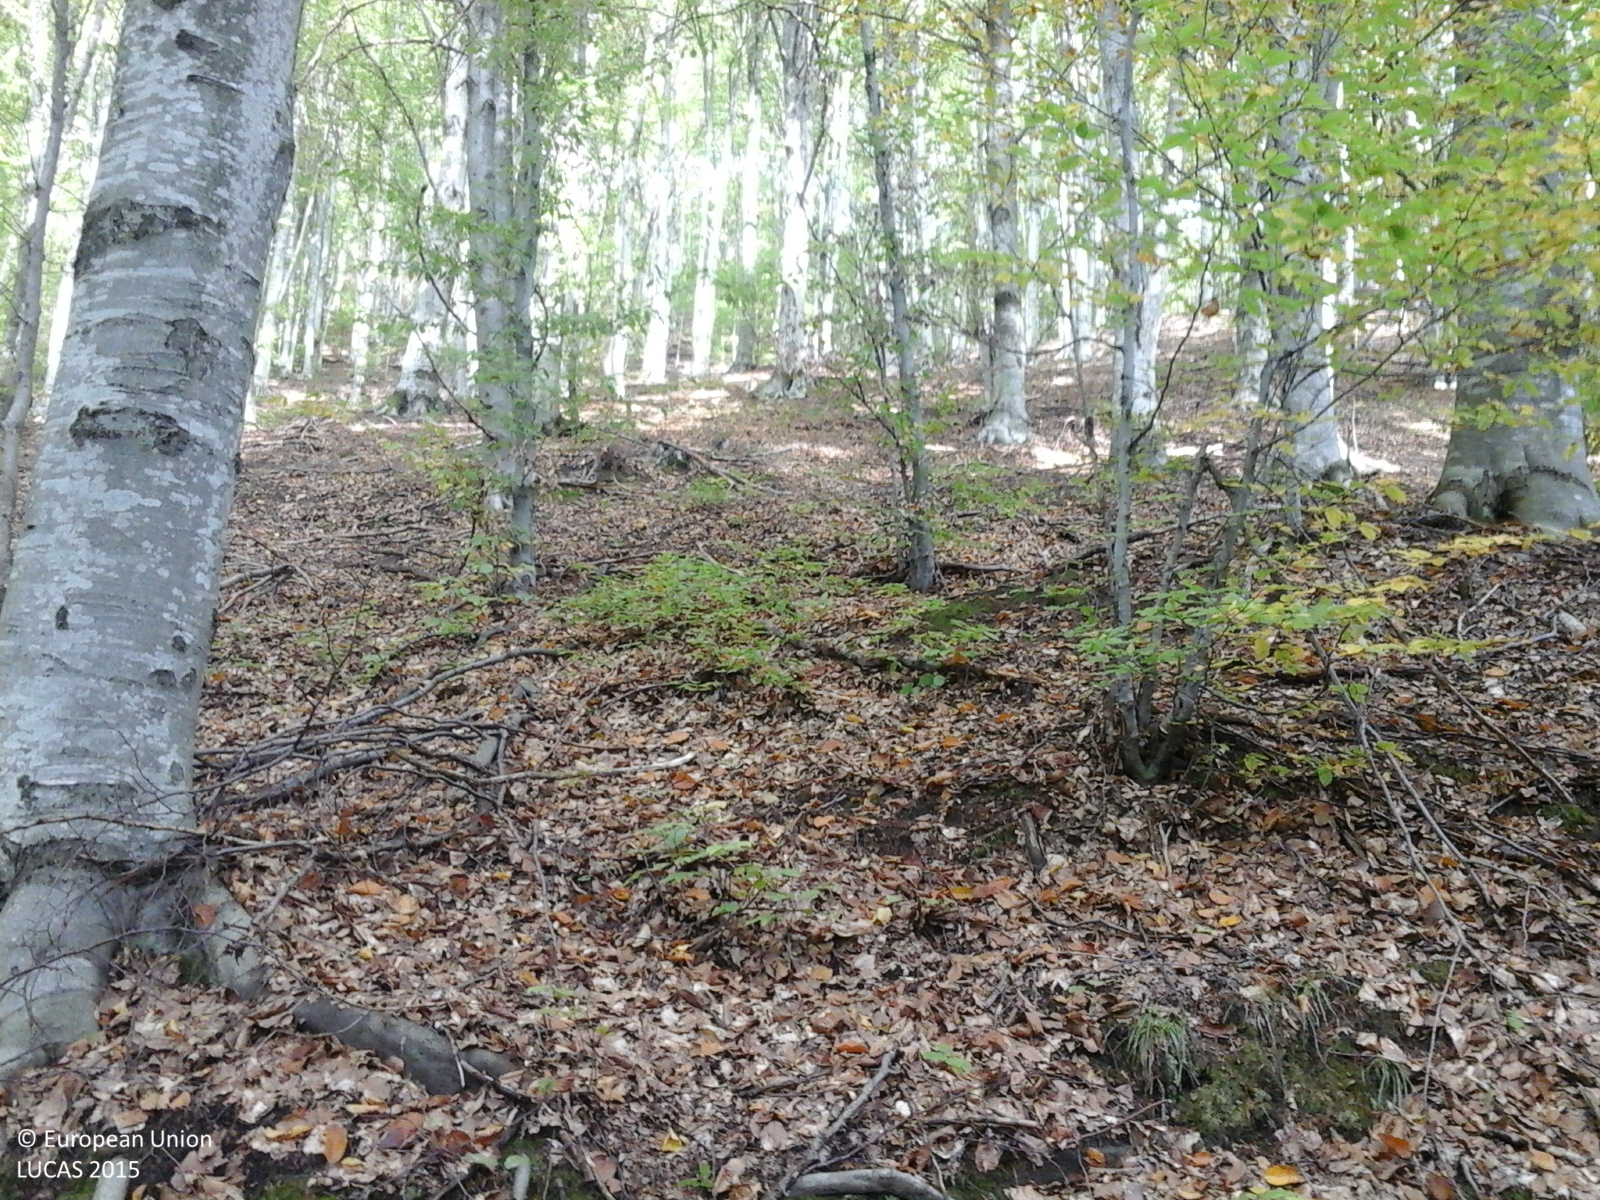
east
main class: Woodland
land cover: Broadleaved woodland
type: beech forest
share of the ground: > 75 %
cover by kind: broadleaved forest trees 100 %
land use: Forestry
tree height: > 5 m
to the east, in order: Broadleaved woodland
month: October
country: RO
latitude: 46.5442
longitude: 25.1635
